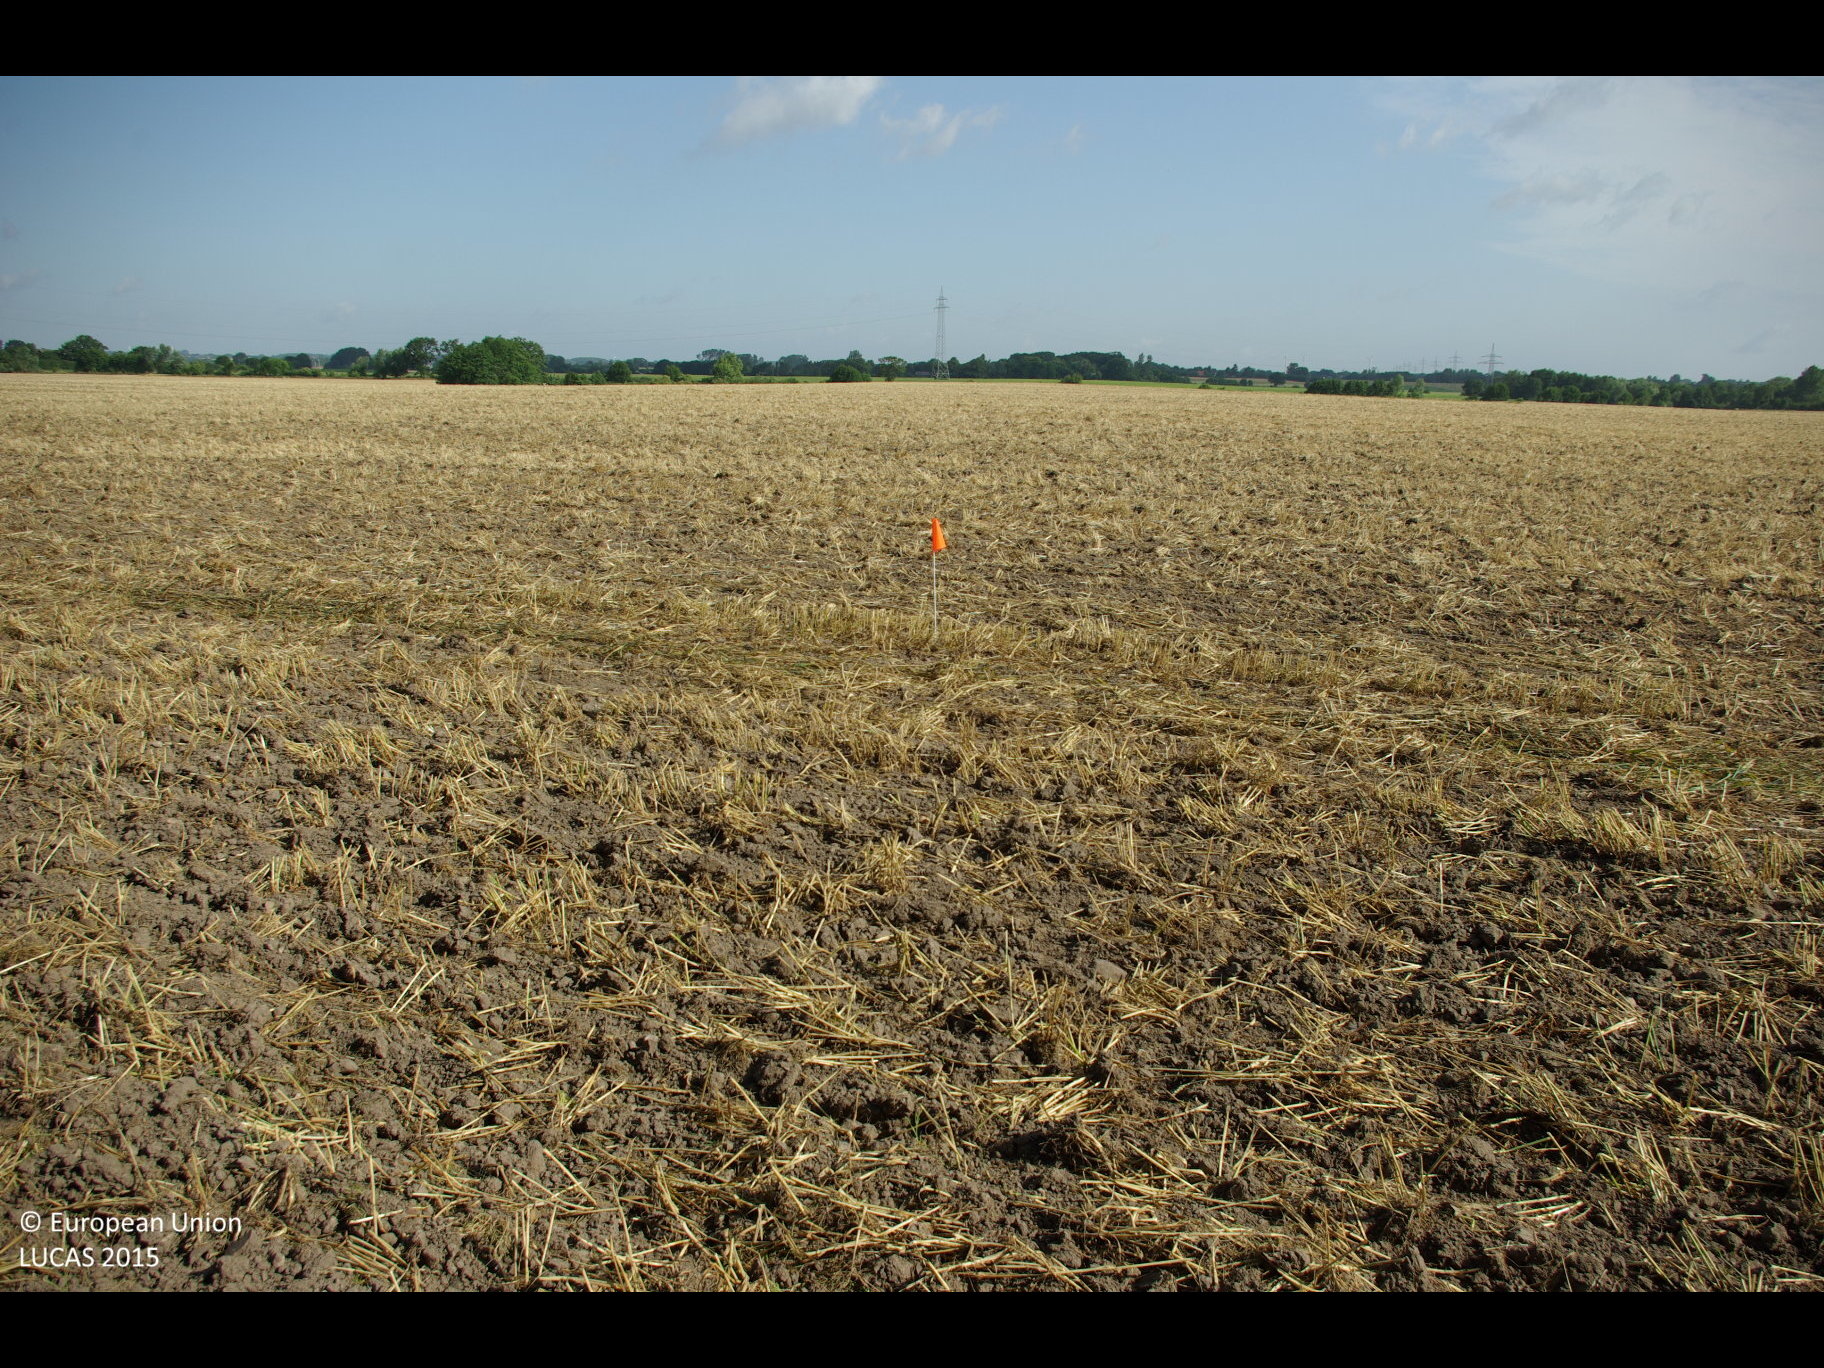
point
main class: Cropland
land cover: Common wheat
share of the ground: < 10 %
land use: Agriculture (excluding fallow land and kitchen gardens)
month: July
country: DE
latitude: 54.6060
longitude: 9.9536
